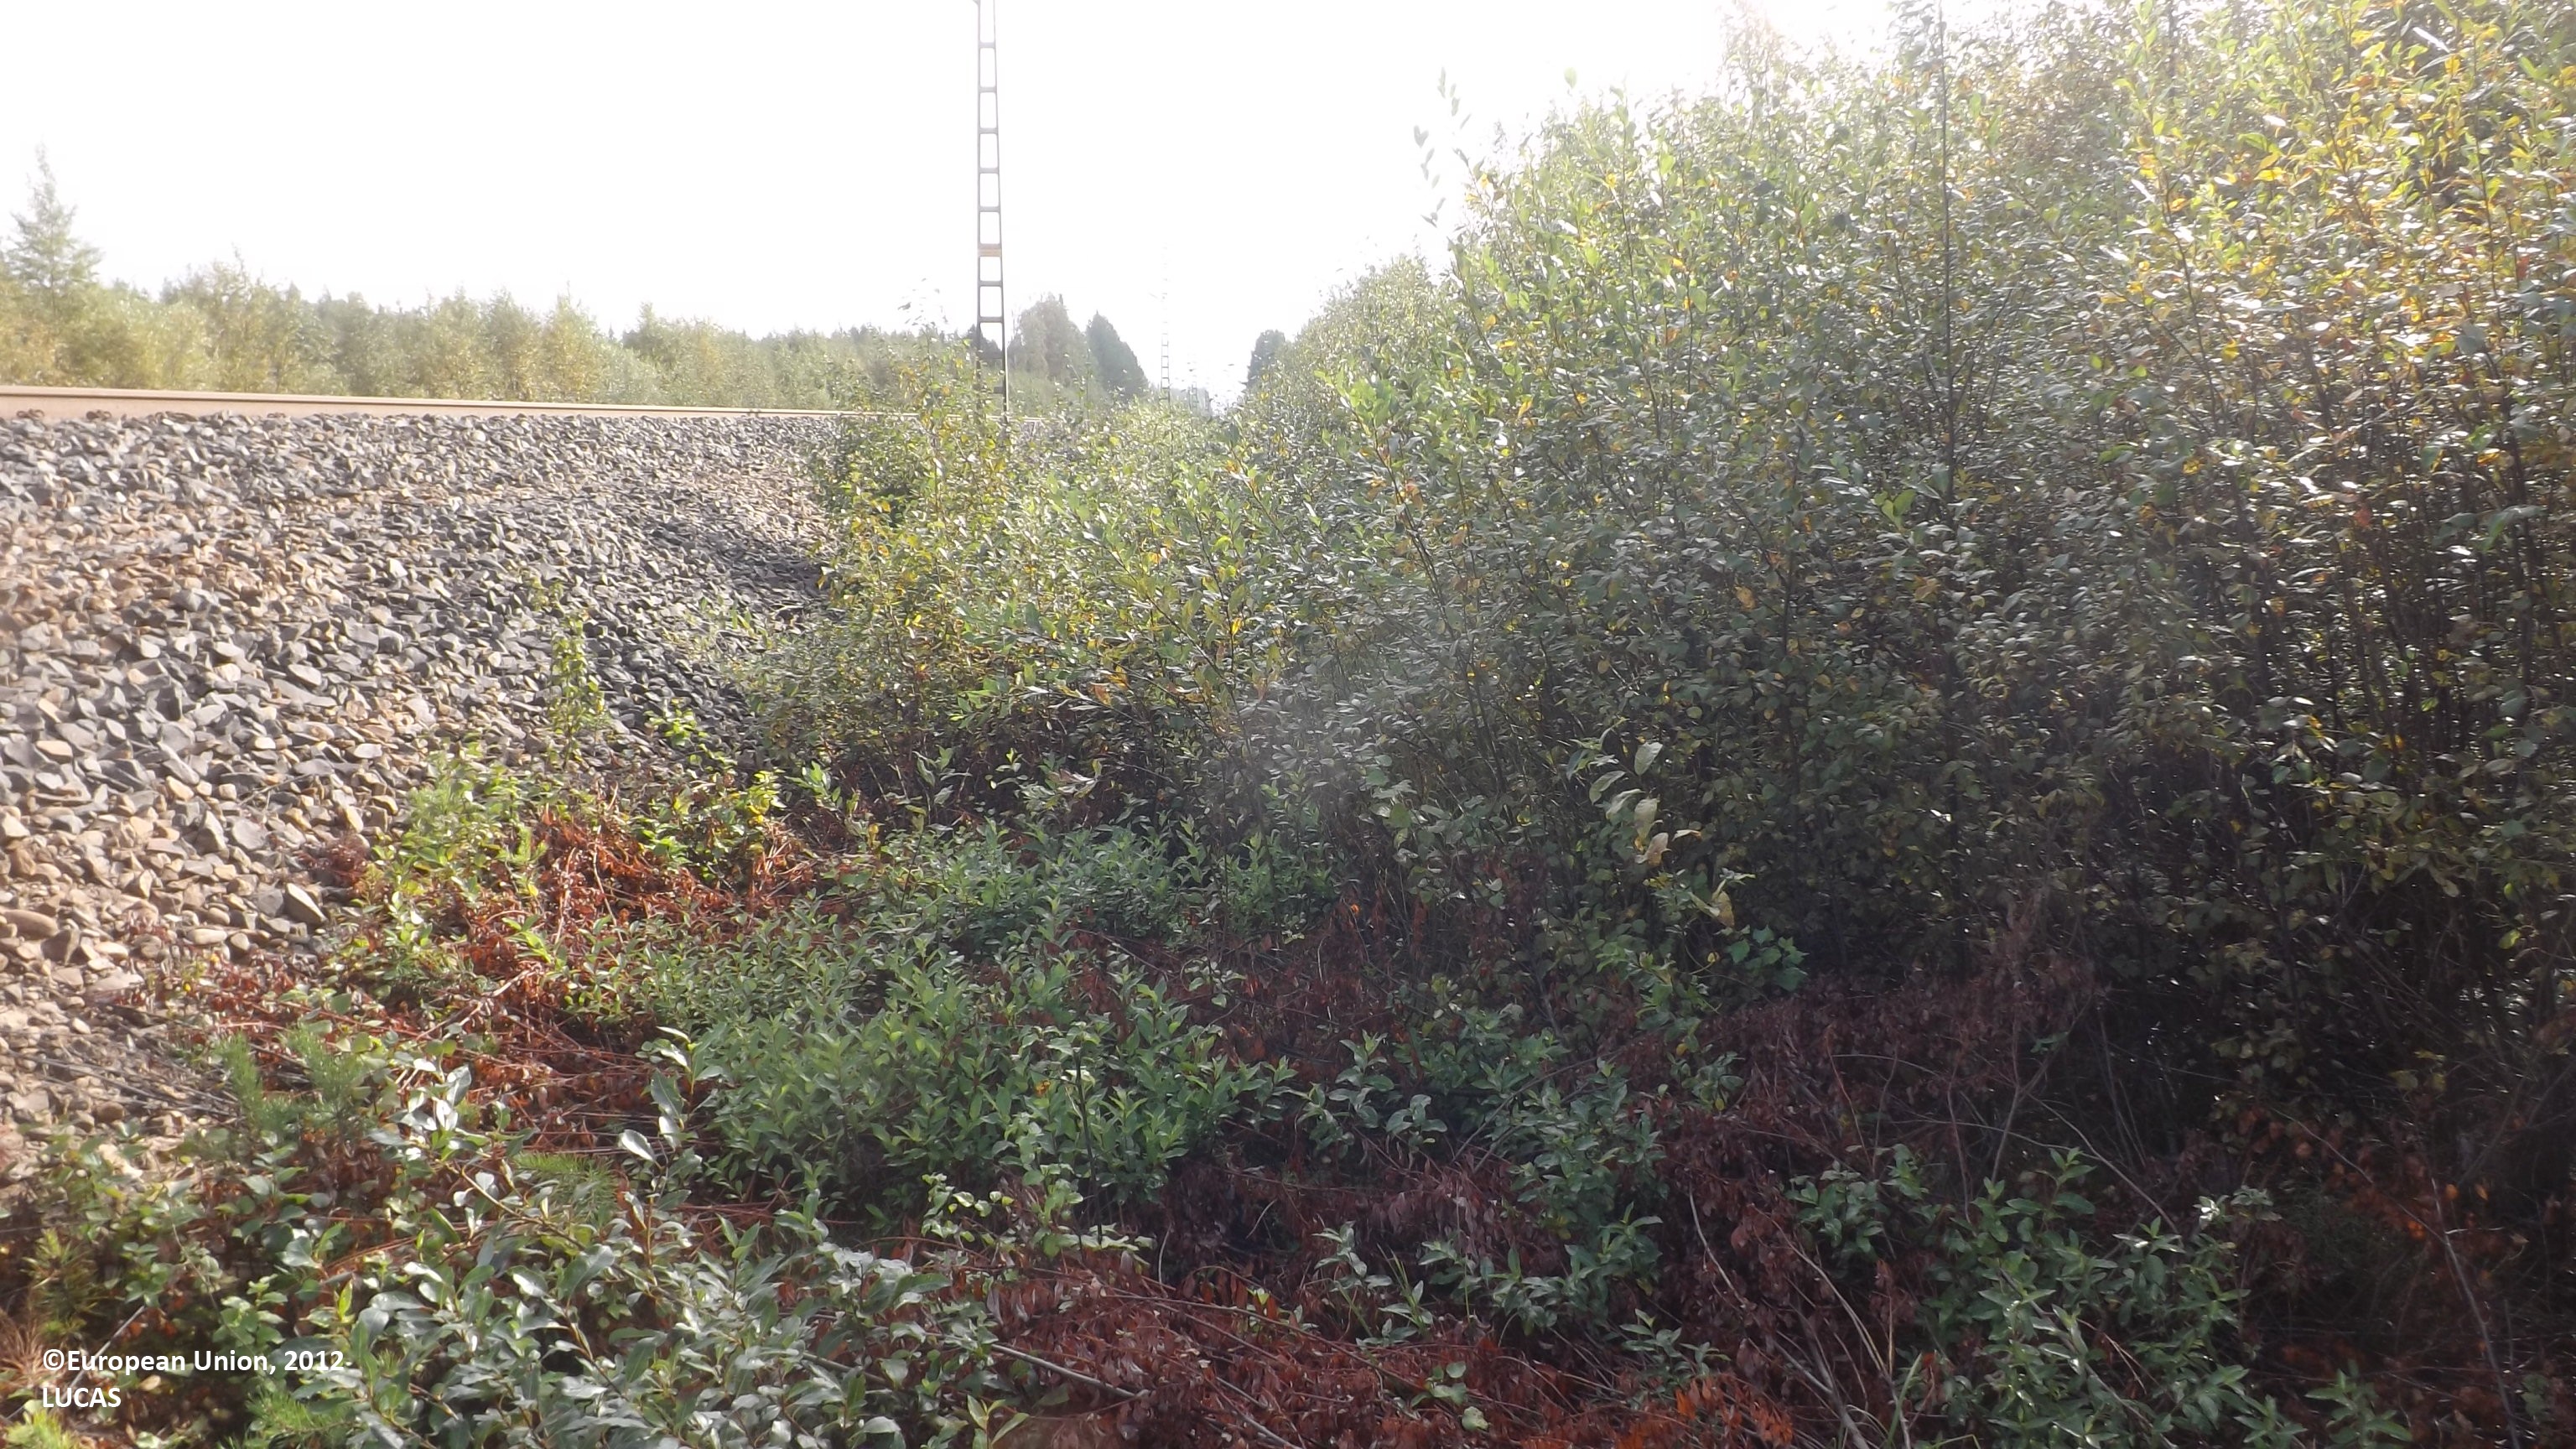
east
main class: Shrubland
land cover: Shrubland with sparse tree cover
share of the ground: > 75 %
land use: Semi-natural and natural areas not in use
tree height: > 5 m
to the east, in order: Shrubland with sparse tree cover; Ditches and canals; Pine dominated mixed woodland
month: August
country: FI
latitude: 63.8687
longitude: 23.5515
